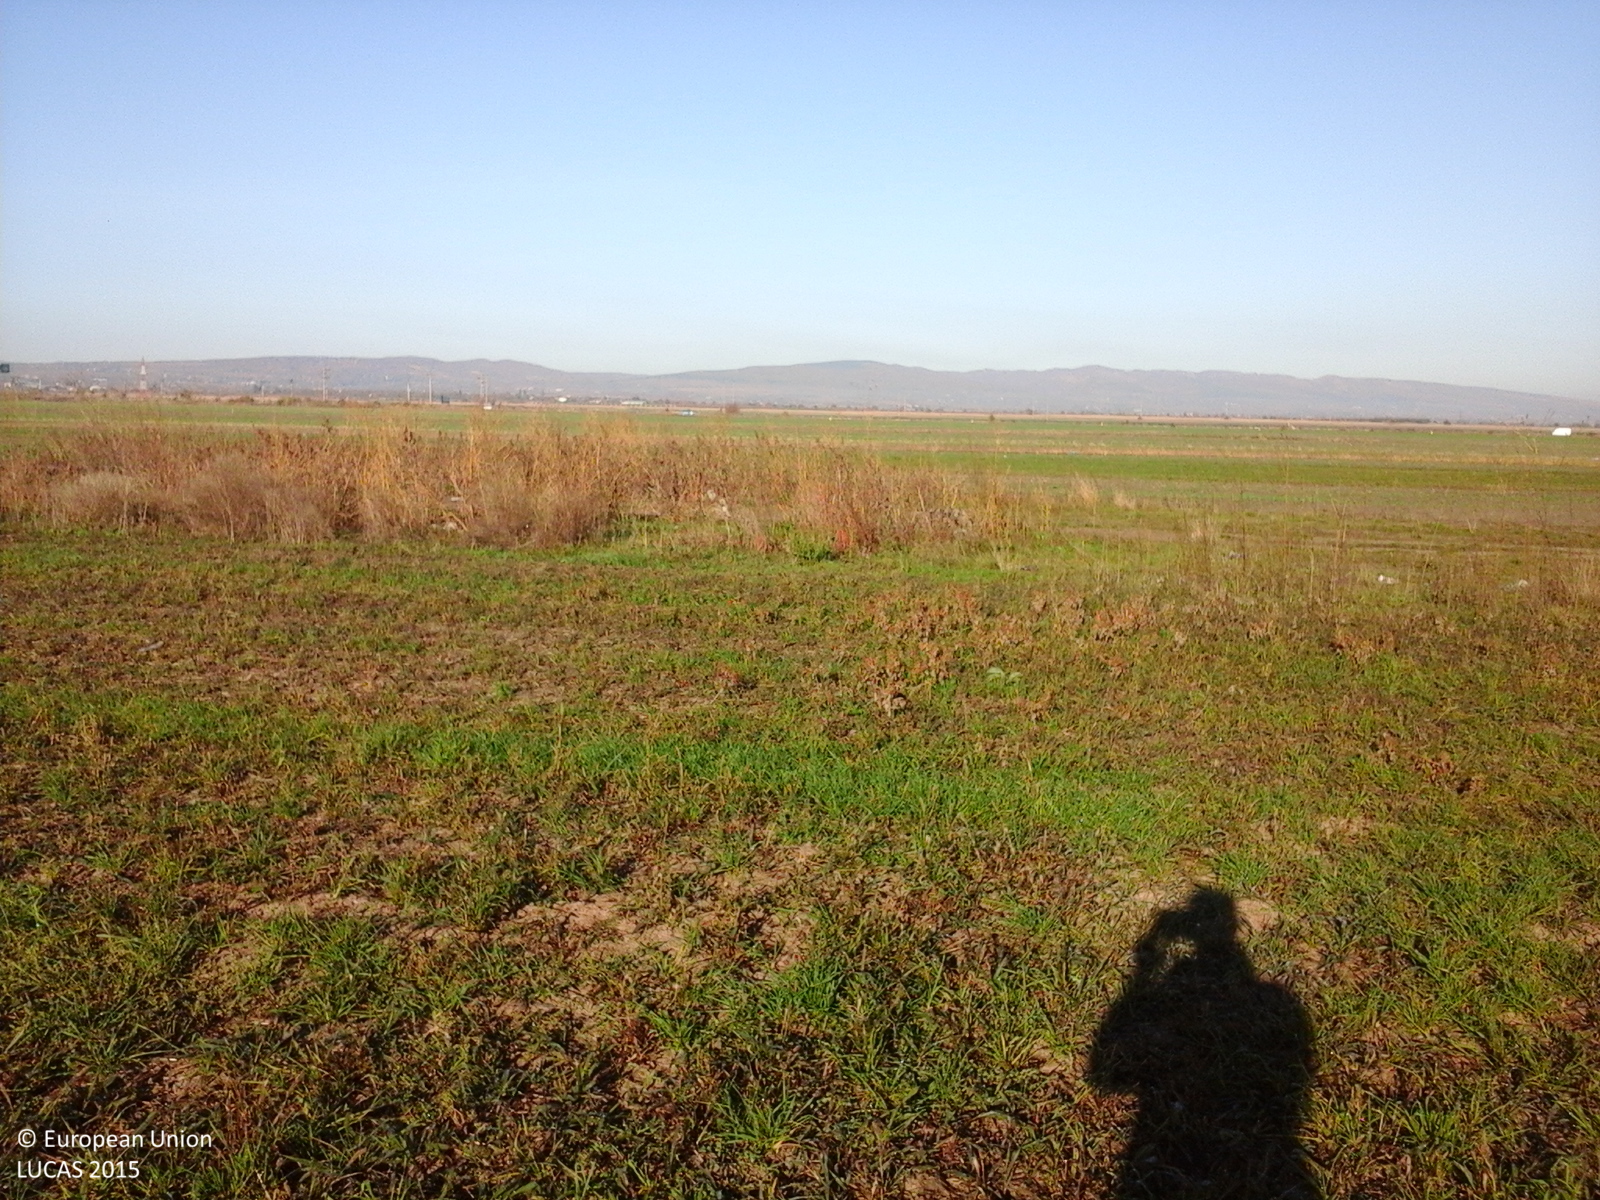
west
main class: Grassland
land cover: Grassland without tree/shrub cover
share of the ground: > 75 %
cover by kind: herbaceous plants 100 %
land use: Agriculture (excluding fallow land and kitchen gardens)
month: October
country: RO
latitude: 45.6348
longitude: 27.1419
